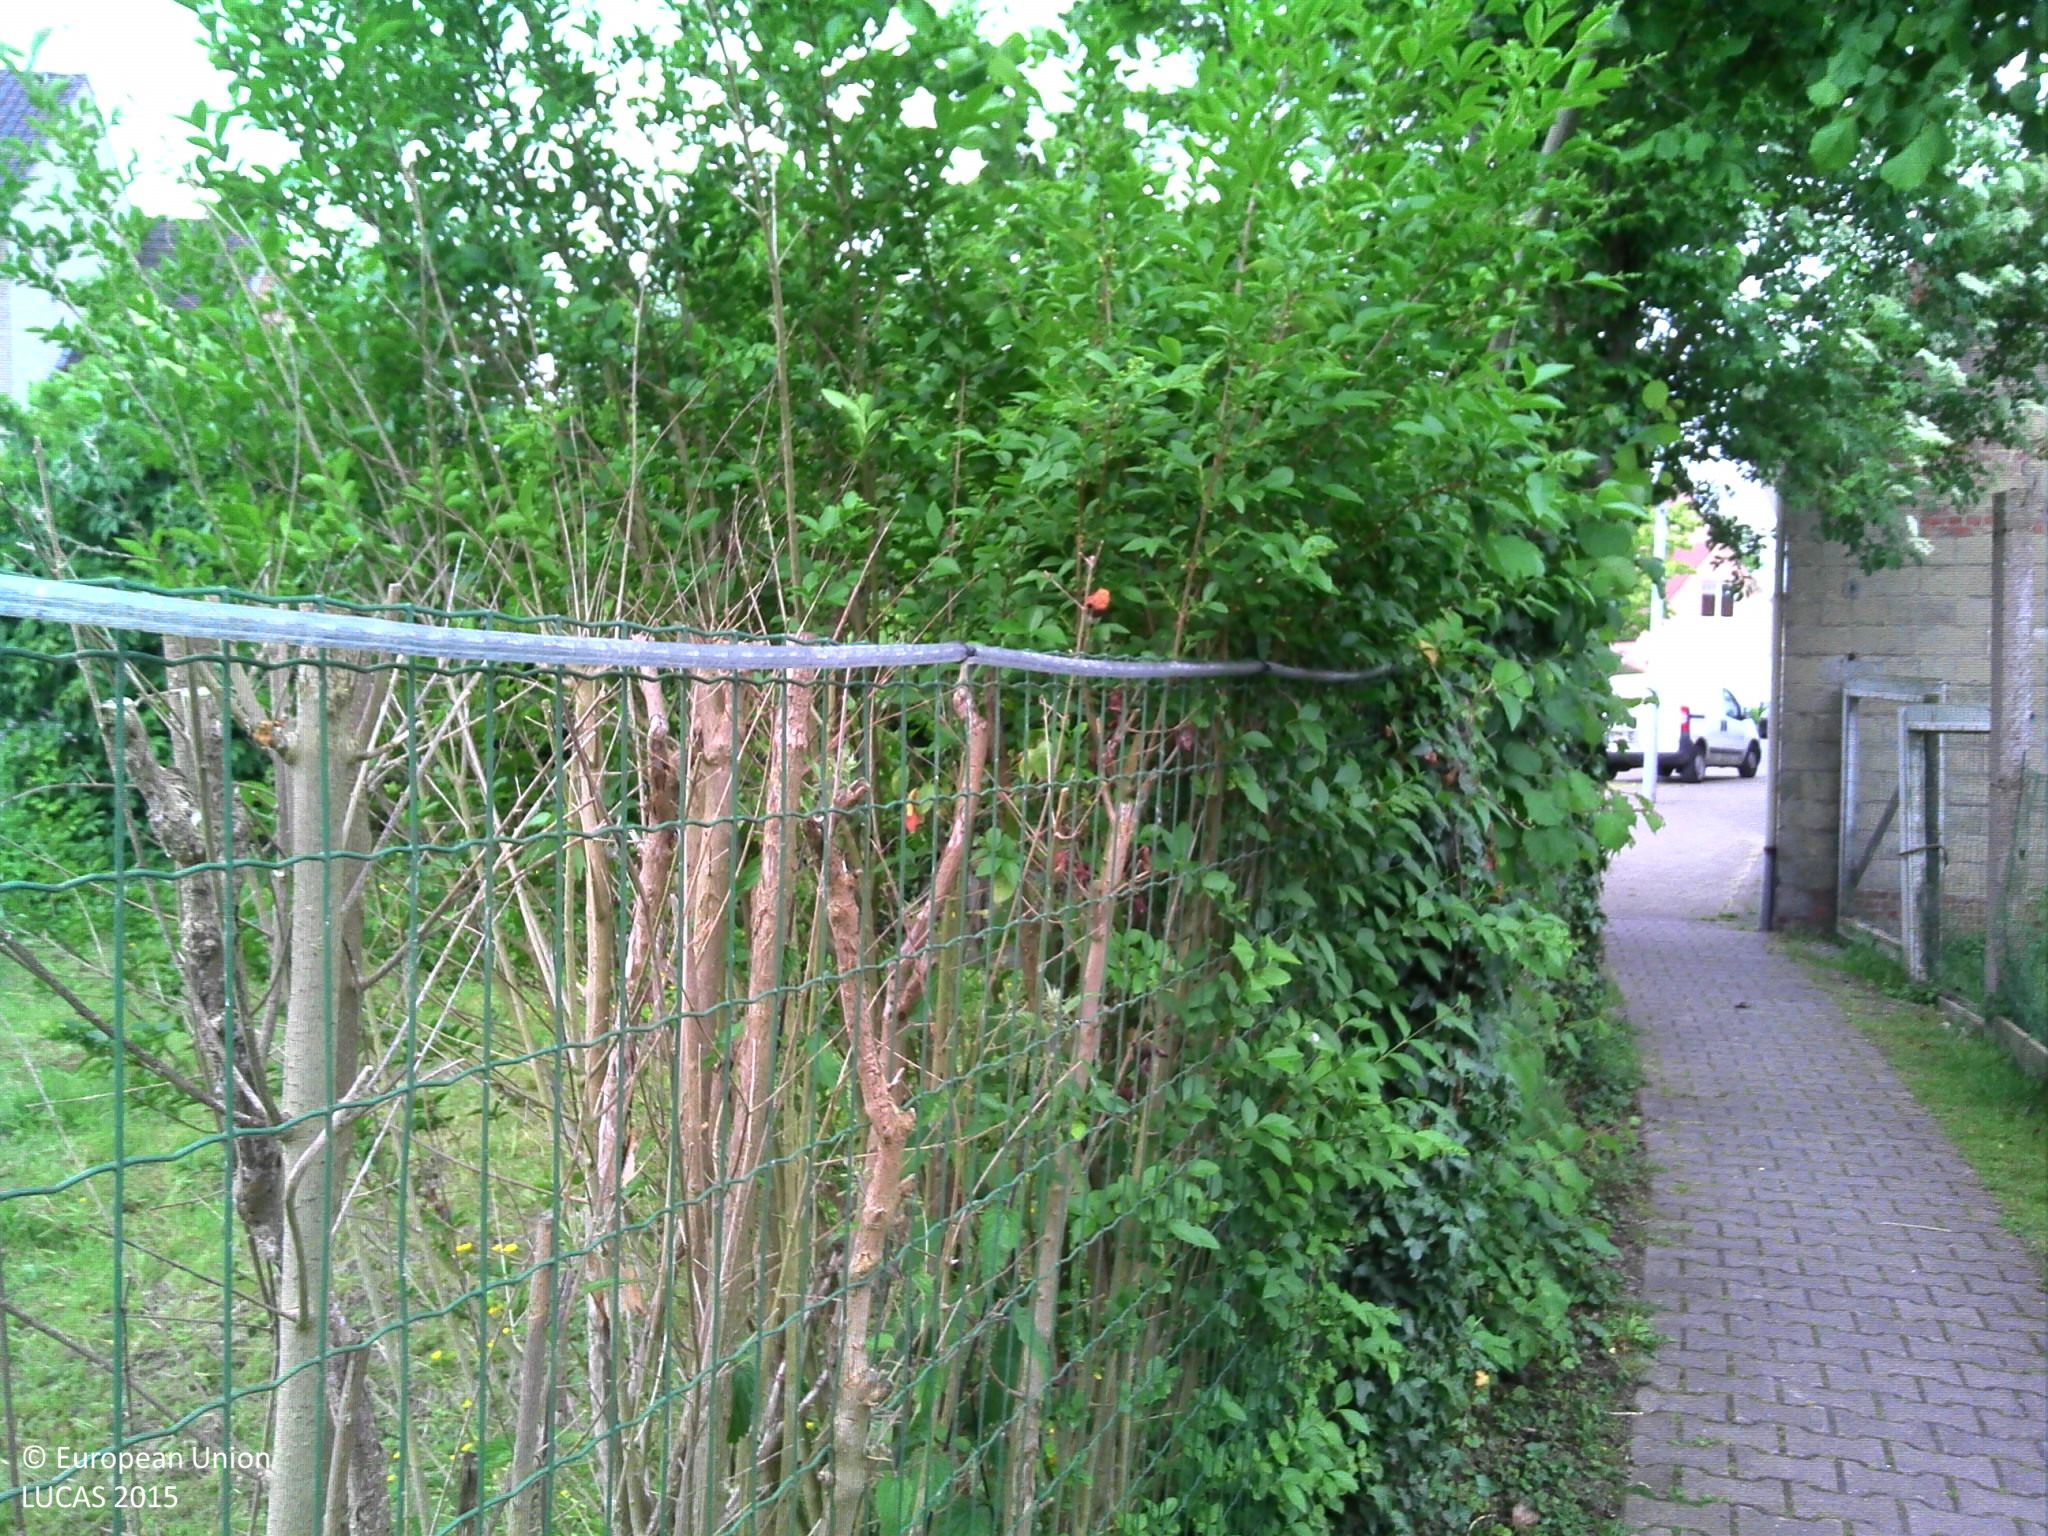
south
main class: Grassland
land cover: Grassland with sparse tree/shrub cover
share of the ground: > 75 %
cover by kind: herbaceous plants 95 %, broadleaved forest trees 5 %
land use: Residential
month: June
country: BE
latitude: 50.9653
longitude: 4.0281
